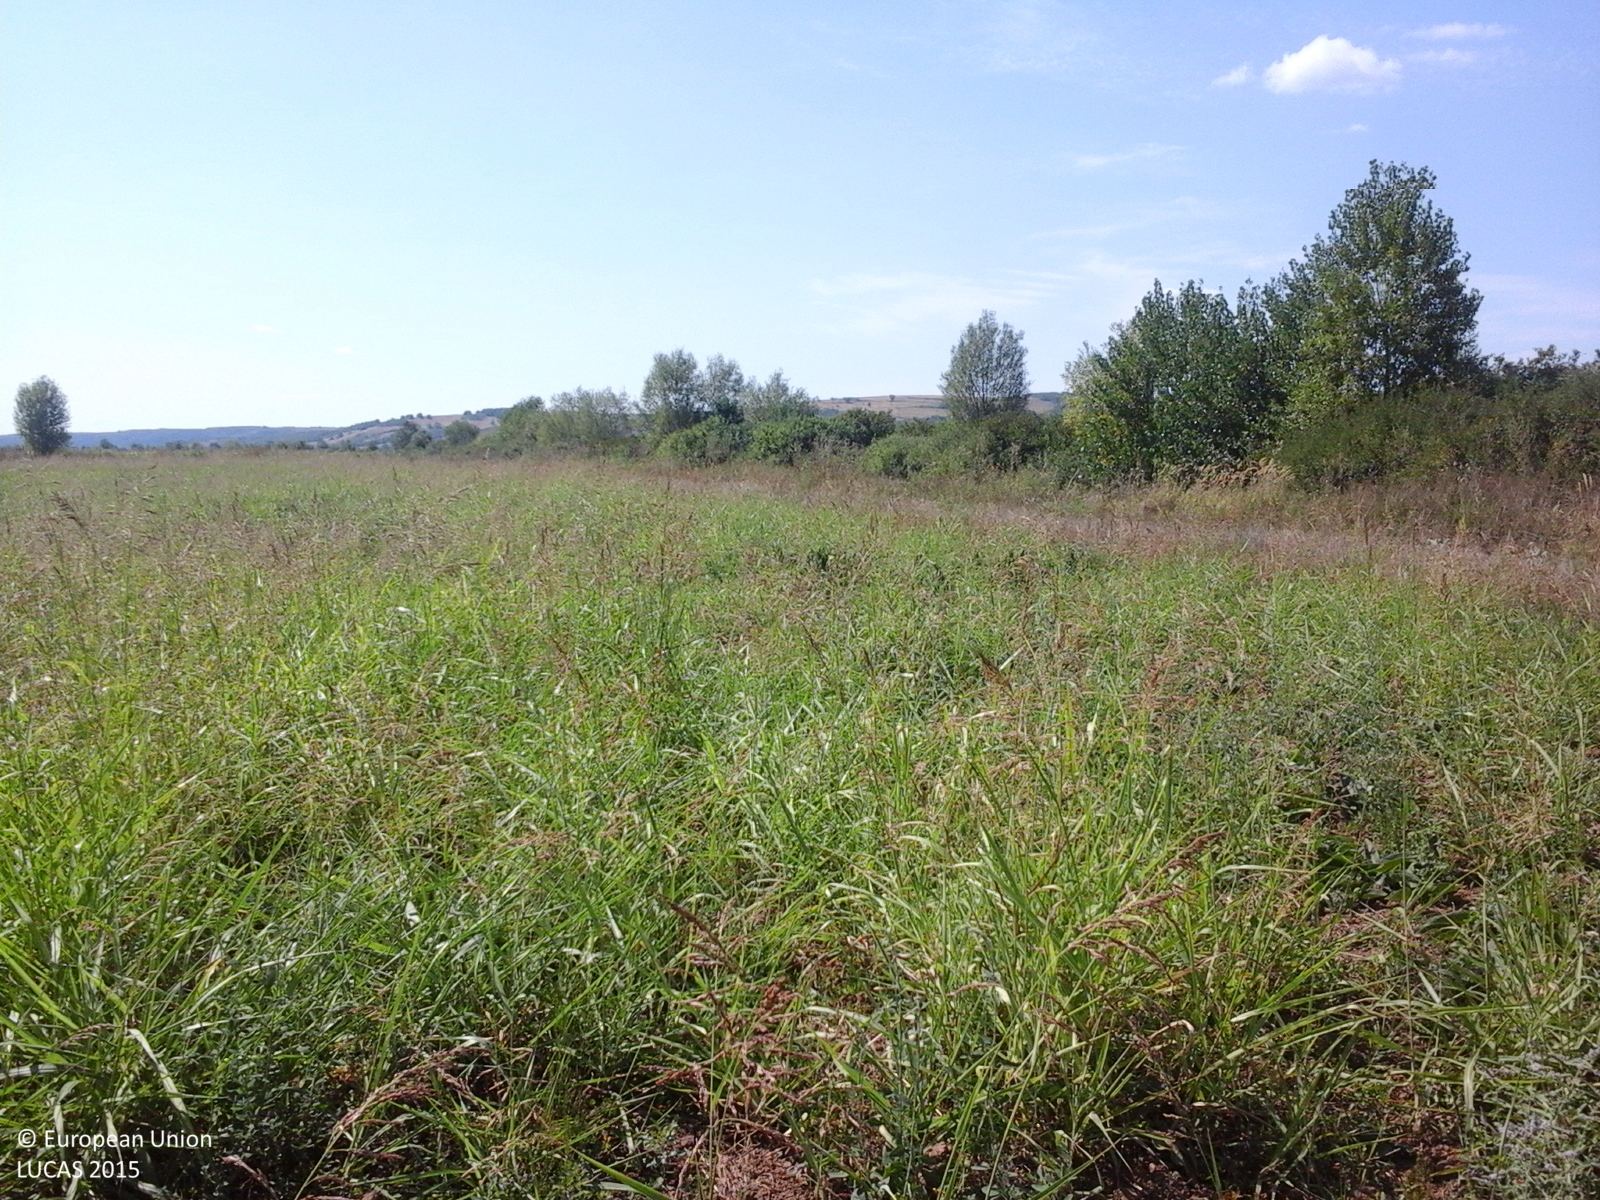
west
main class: Grassland
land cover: Spontaneously vegetated surfaces
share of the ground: > 75 %
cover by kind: herbaceous plants 100 %
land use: Fallow land
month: August
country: RO
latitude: 45.0711
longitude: 21.5249
